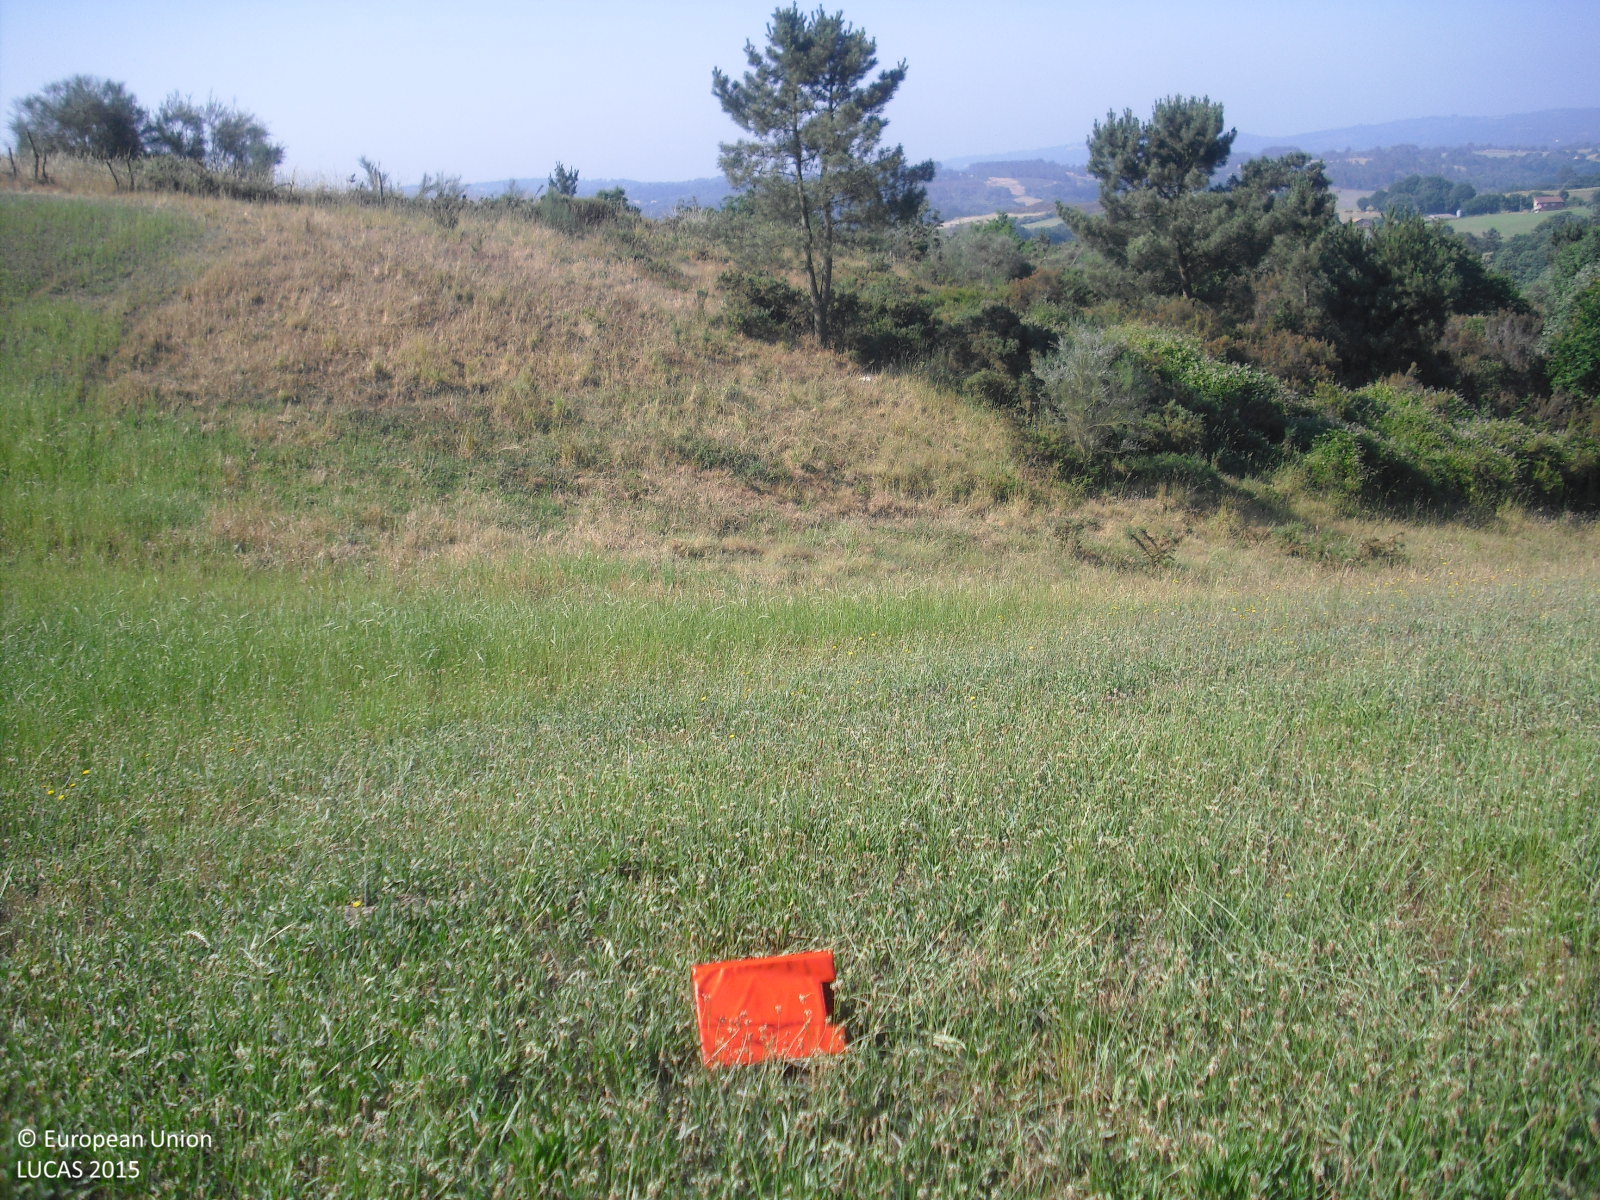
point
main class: Cropland
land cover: Temporary grasslands
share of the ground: > 75 %
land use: Agriculture (excluding fallow land and kitchen gardens)
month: June
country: ES
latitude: 42.5476
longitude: -7.7465
